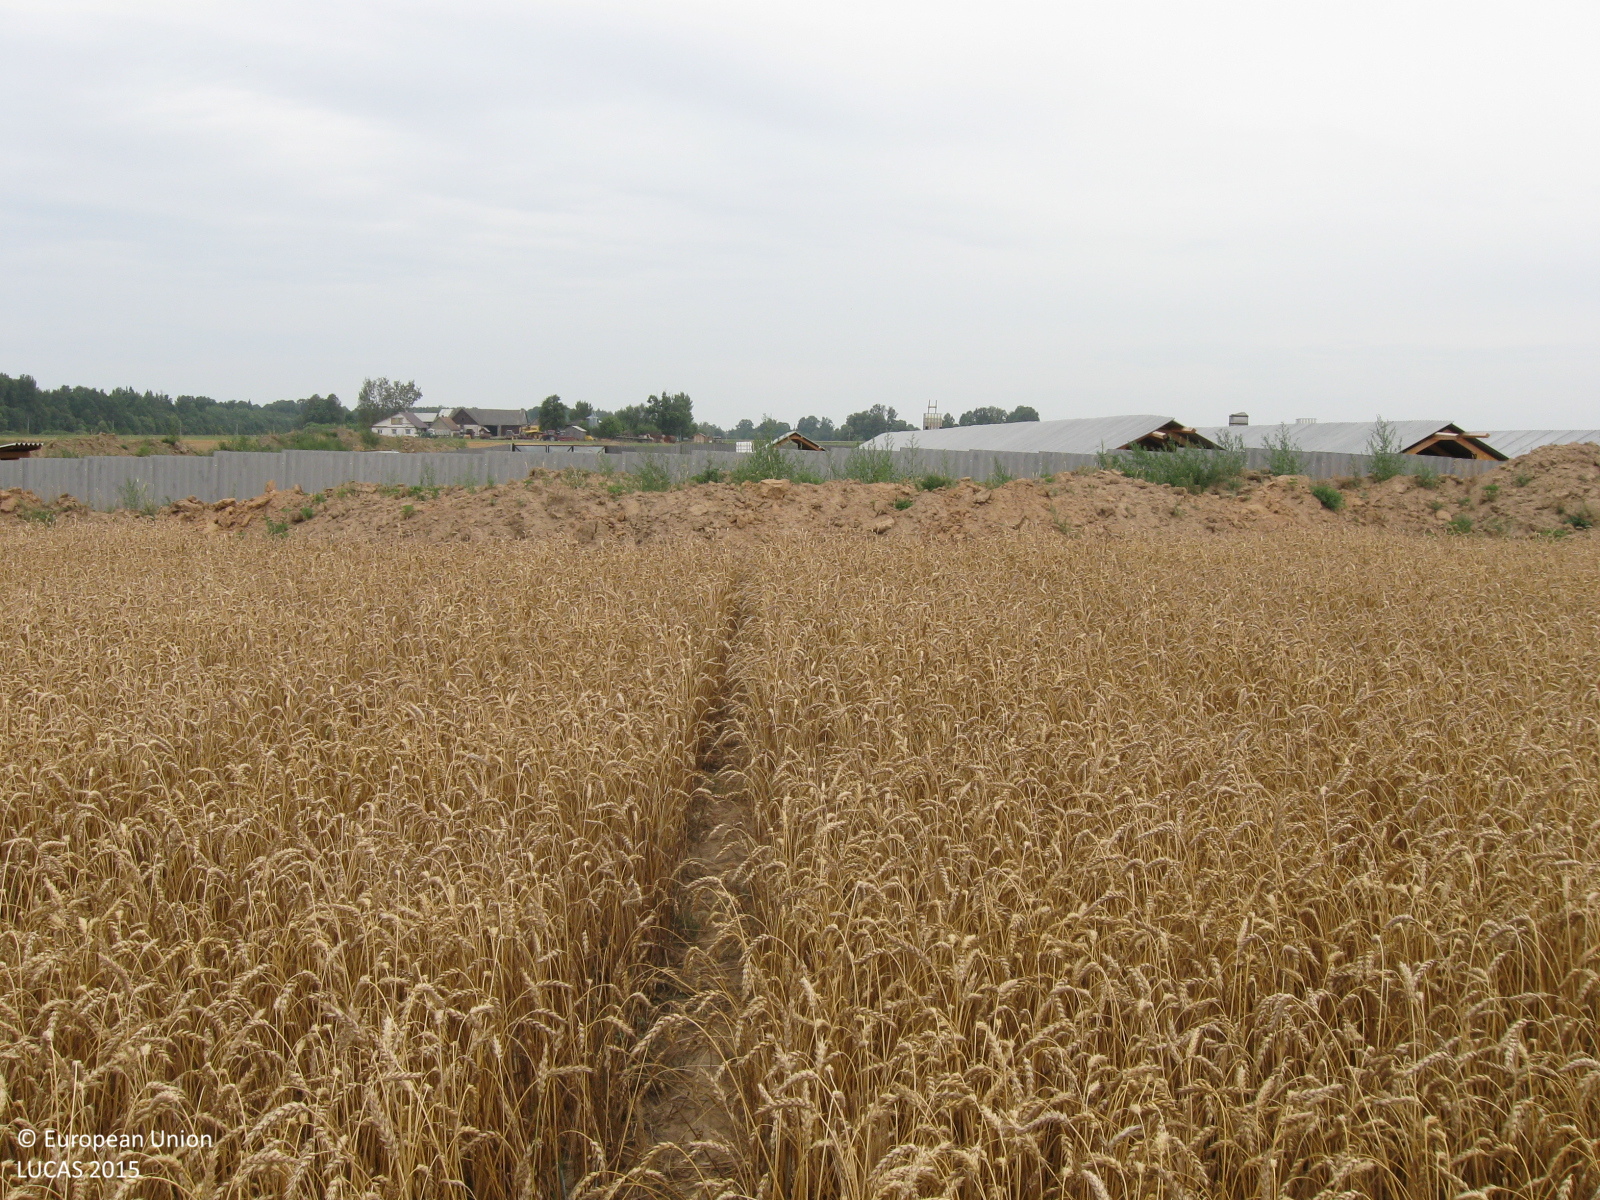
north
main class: Cropland
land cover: Common wheat
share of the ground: > 75 %
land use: Agriculture (excluding fallow land and kitchen gardens)
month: August
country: LT
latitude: 55.1168
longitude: 23.3893
